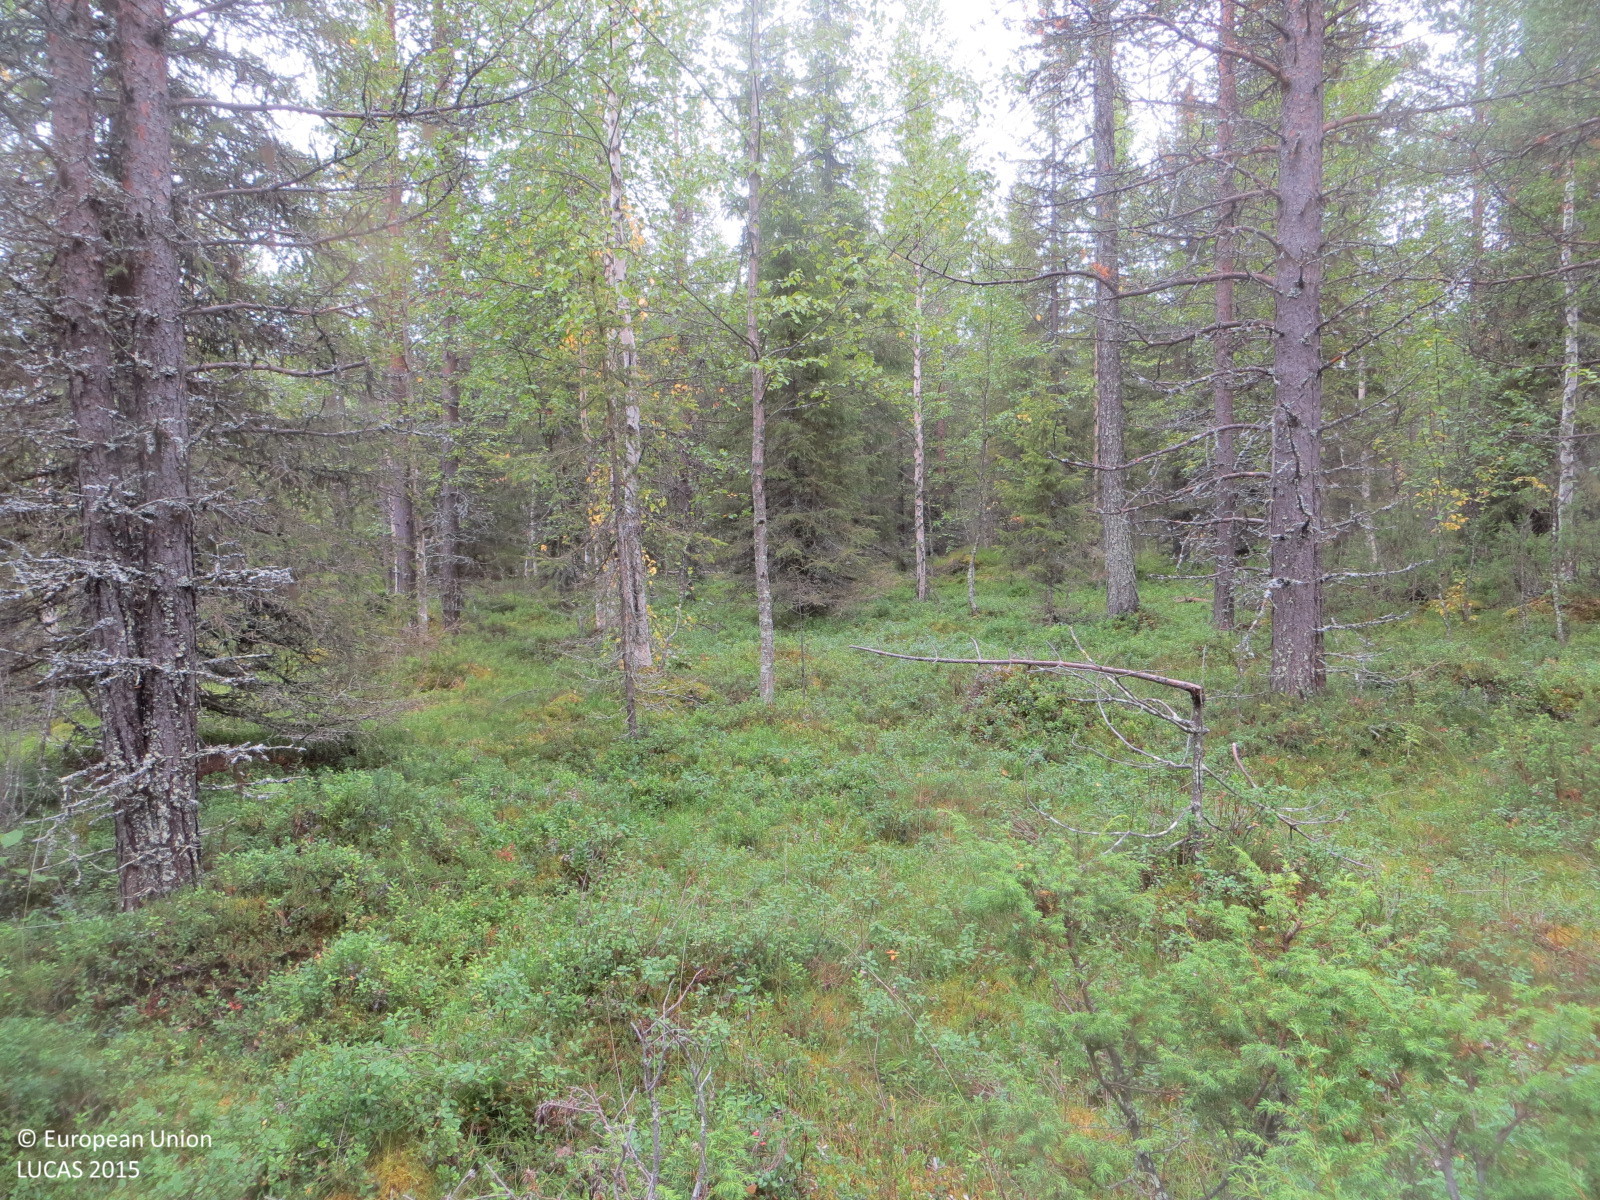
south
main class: Woodland
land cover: Other mixed woodland
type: boreal forest
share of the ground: 50 - 75 %
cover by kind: shrubs 50 %, coniferous forest trees 25 %, broadleaved forest trees 25 %
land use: Forestry
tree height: > 5 m
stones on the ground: < 10 %
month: August
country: FI
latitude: 67.5534
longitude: 24.4629
